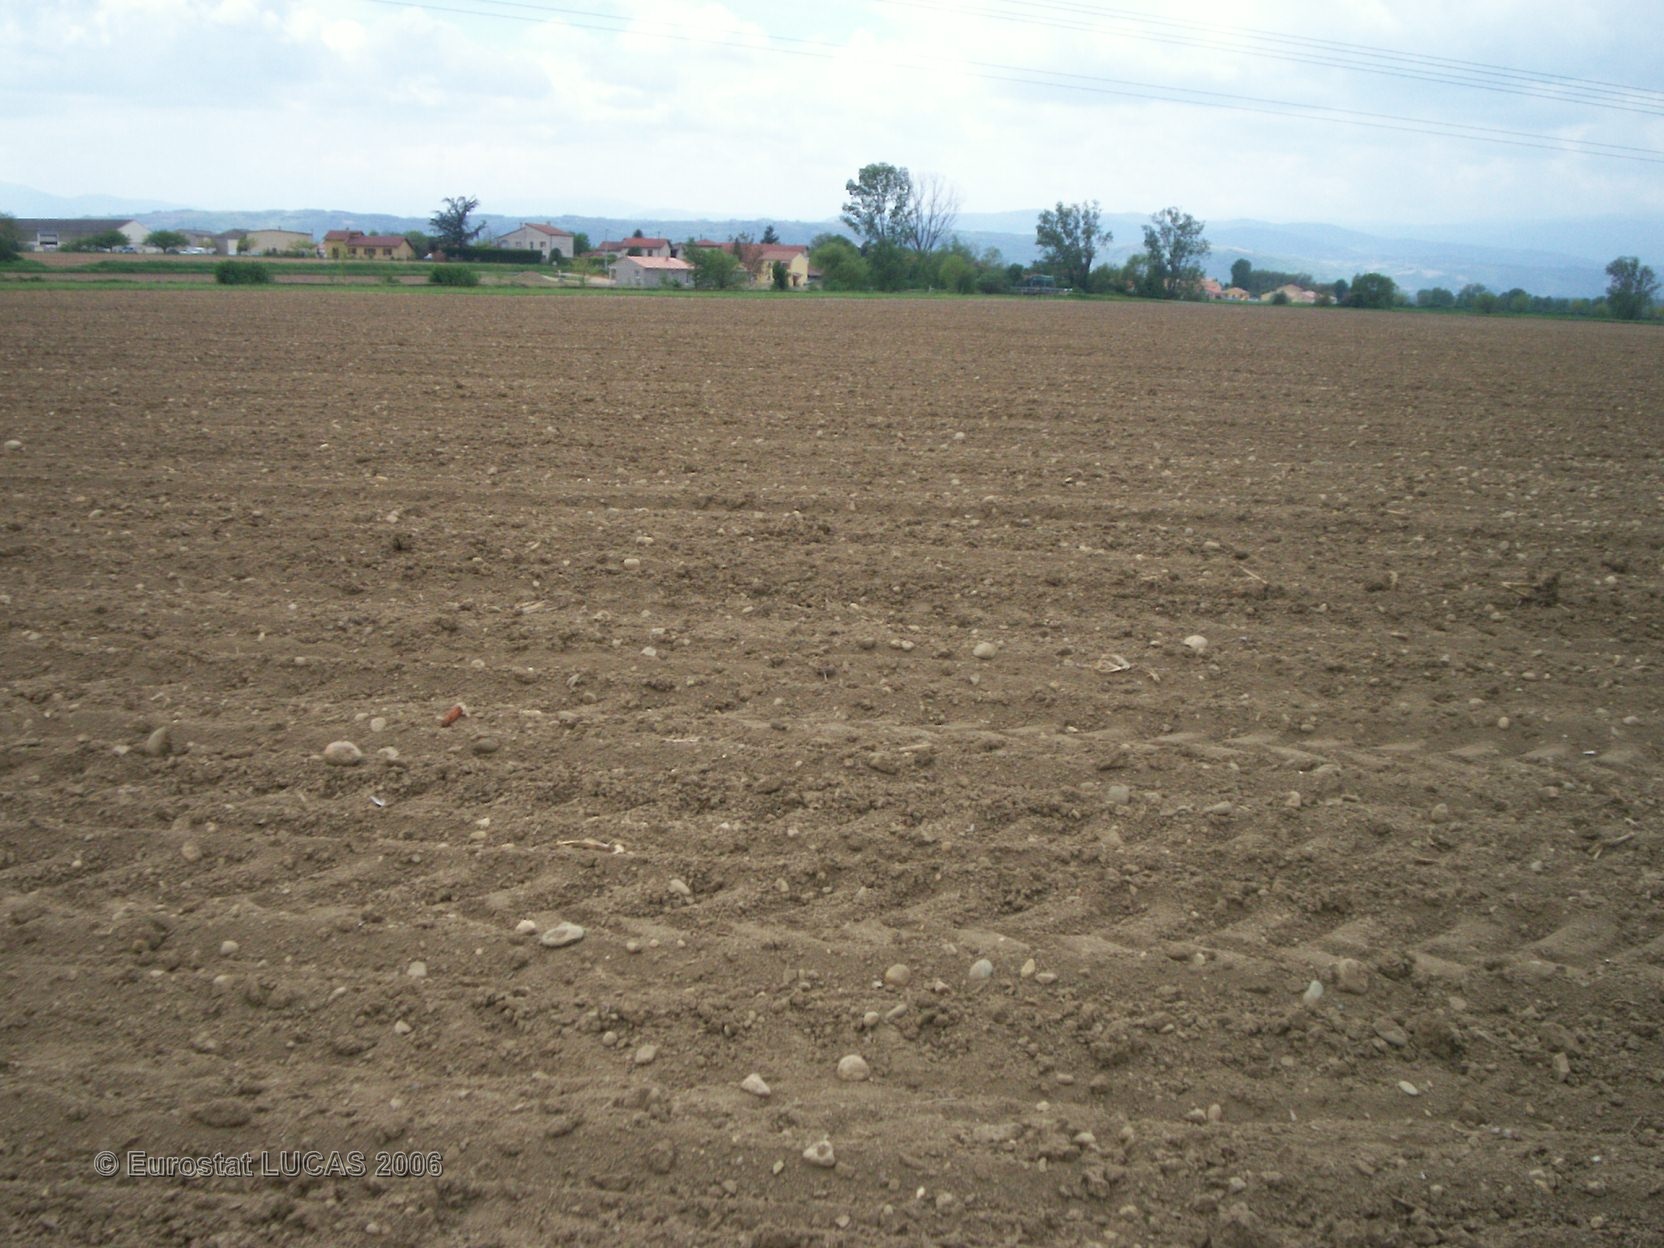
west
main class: Cropland
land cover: Maize
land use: Agriculture (excluding fallow land and kitchen gardens)
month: April
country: FR
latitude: 45.2893
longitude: 4.8664
